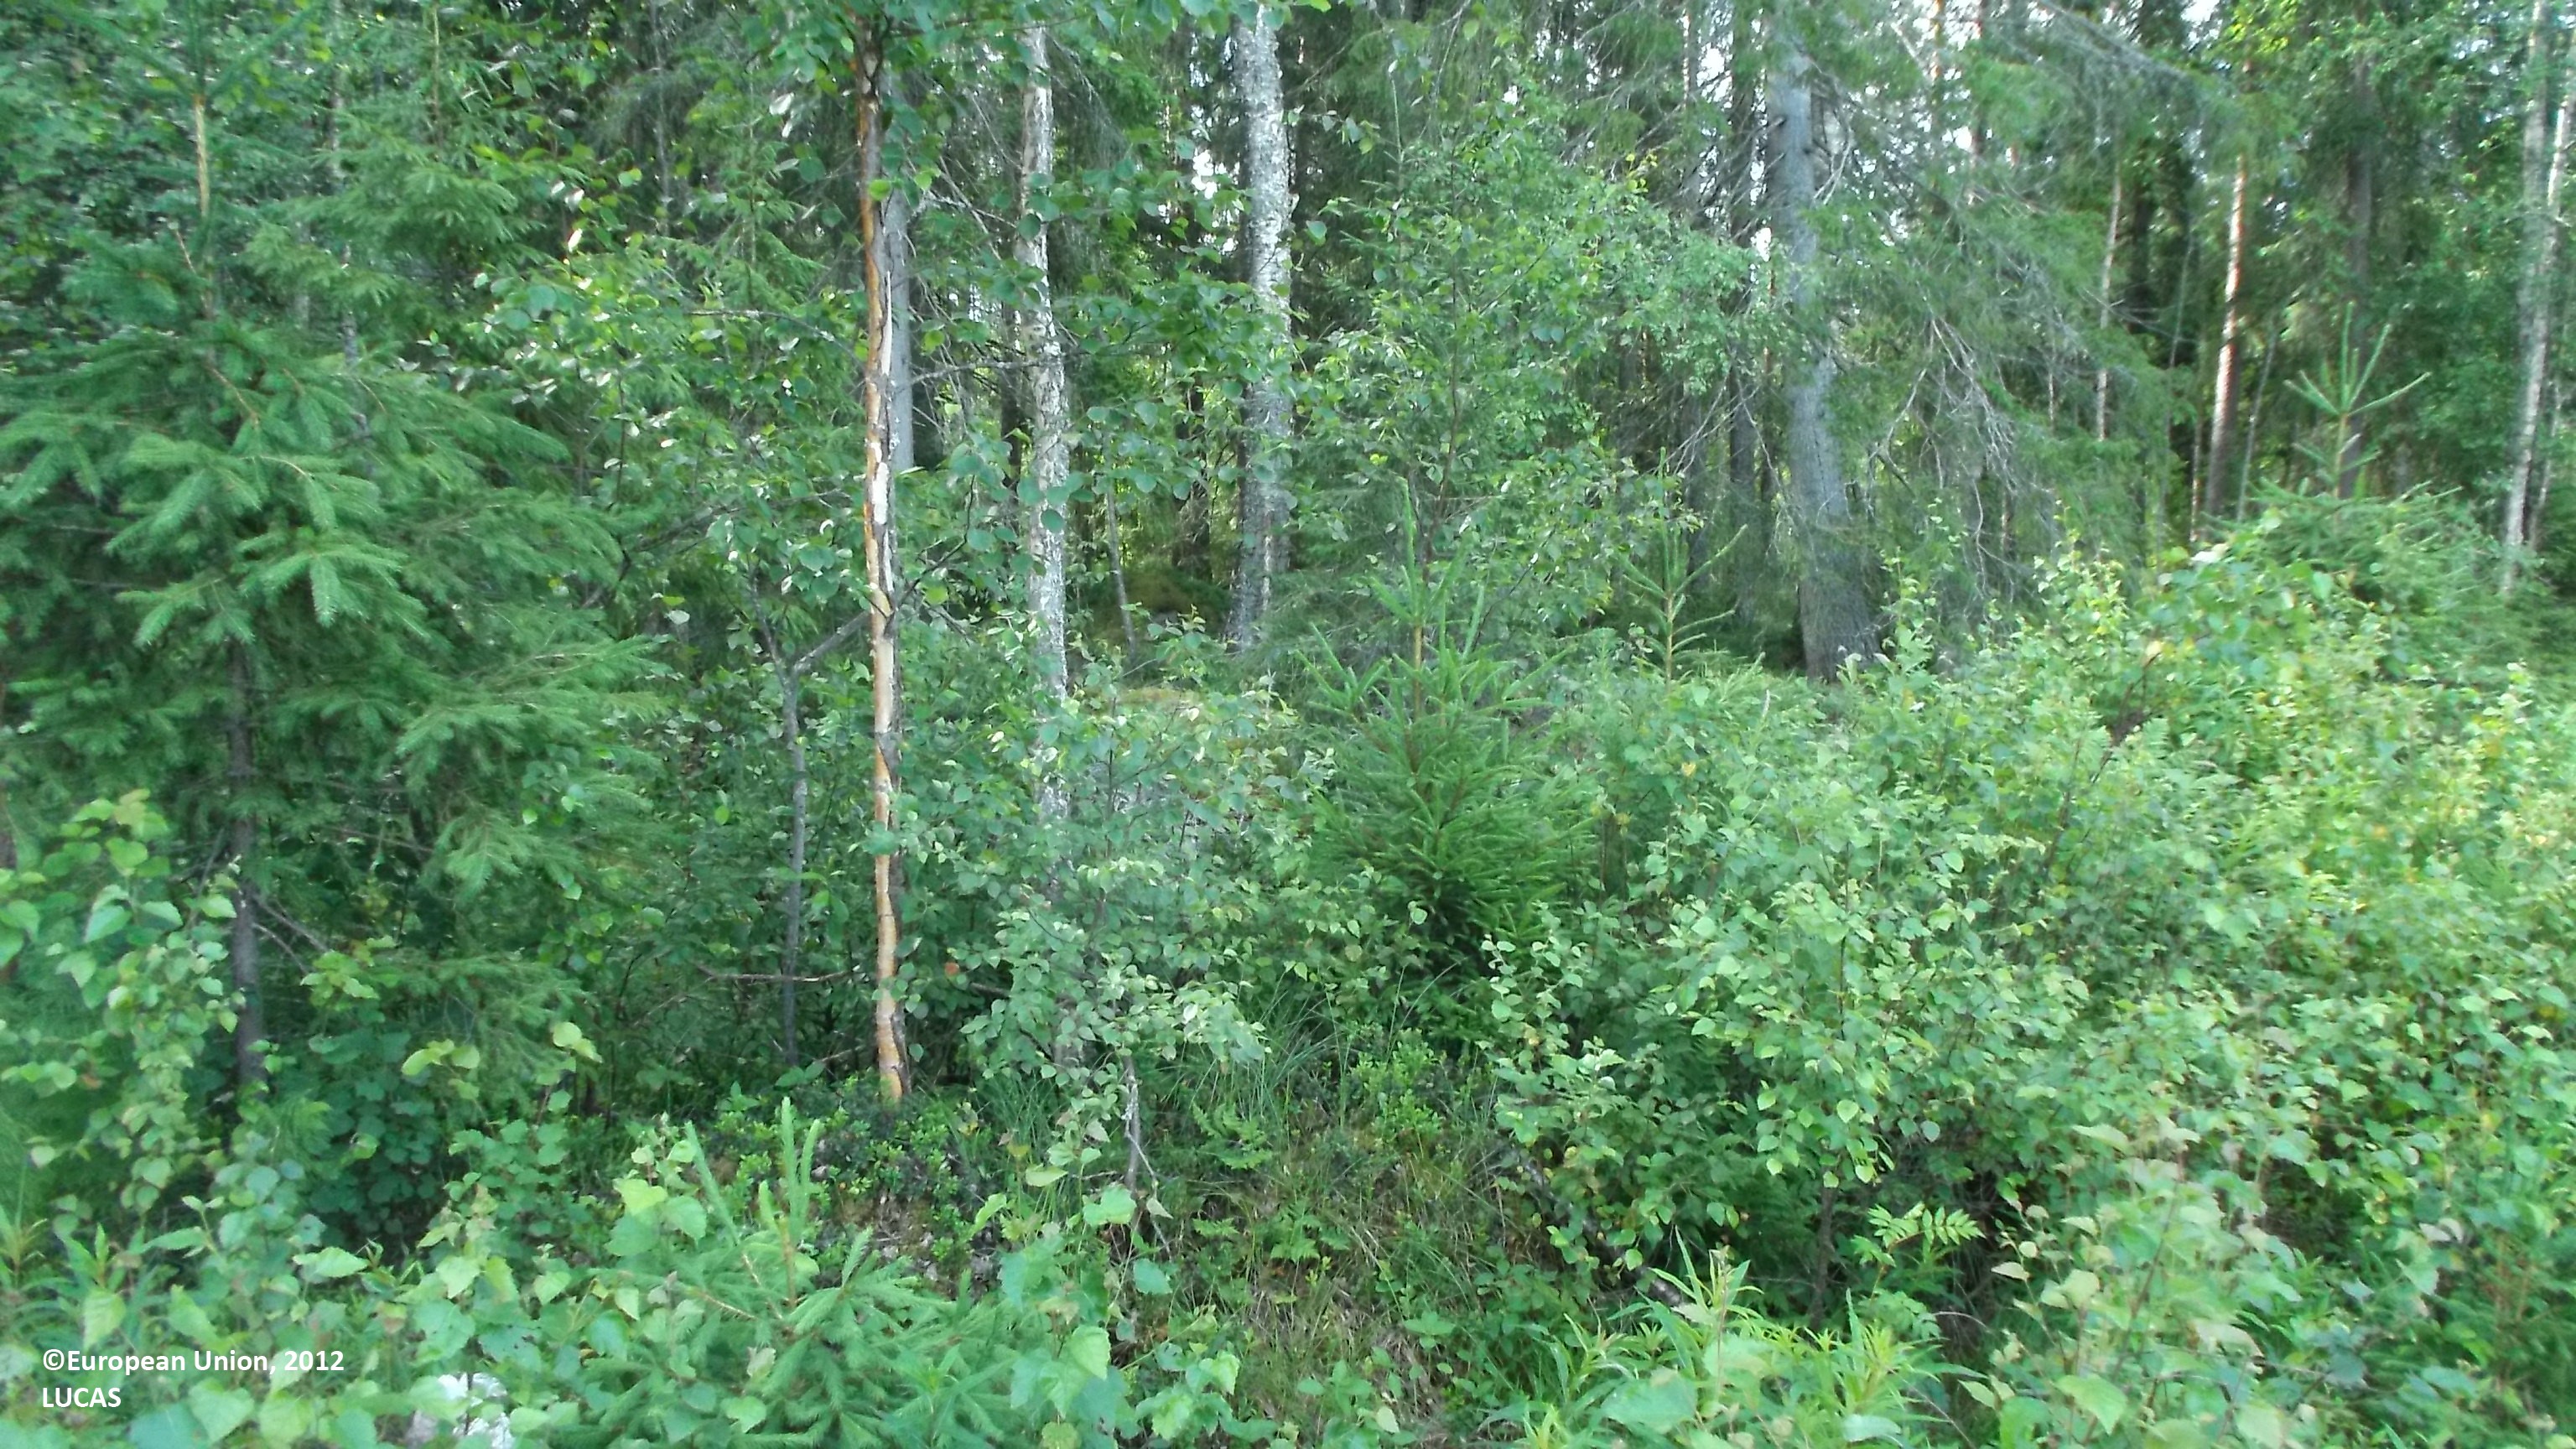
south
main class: Woodland
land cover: Broadleaved woodland
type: boreal forest
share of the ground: > 75 %
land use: Forestry
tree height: < 5 m
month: July
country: FI
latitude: 63.5056
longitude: 23.9121
